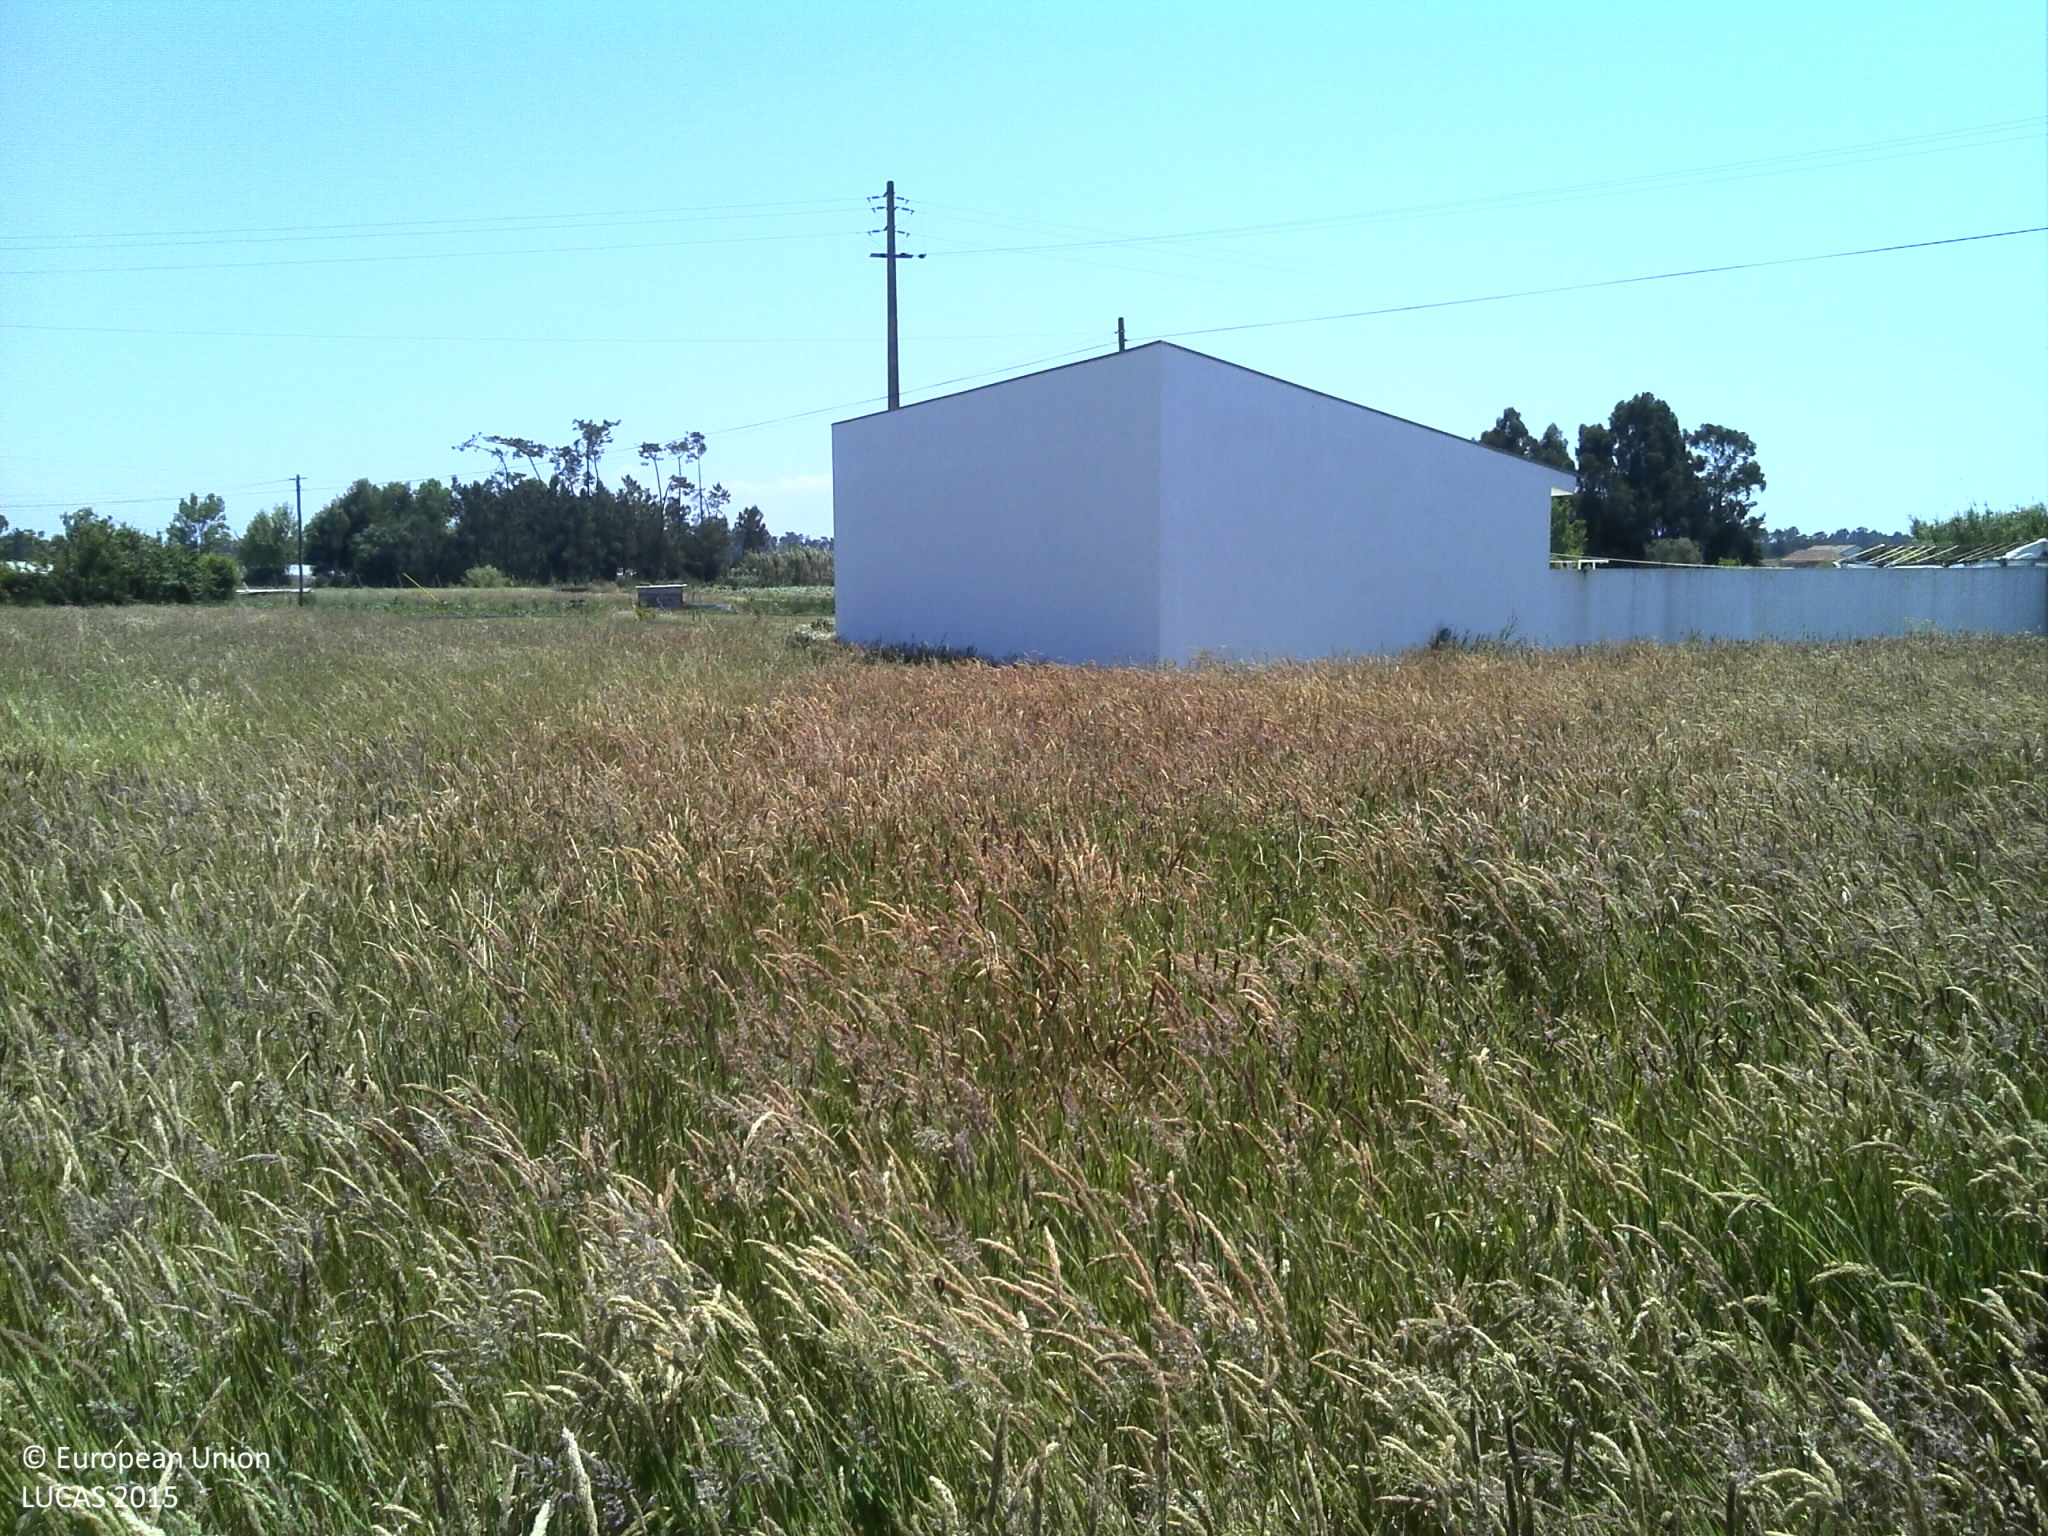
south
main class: Grassland
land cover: Grassland without tree/shrub cover
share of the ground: 50 - 75 %
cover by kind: herbaceous plants 75 %, unconsolidated bare surface 25 %
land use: Agriculture (excluding fallow land and kitchen gardens)
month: May
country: PT
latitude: 40.4693
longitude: -8.6956
